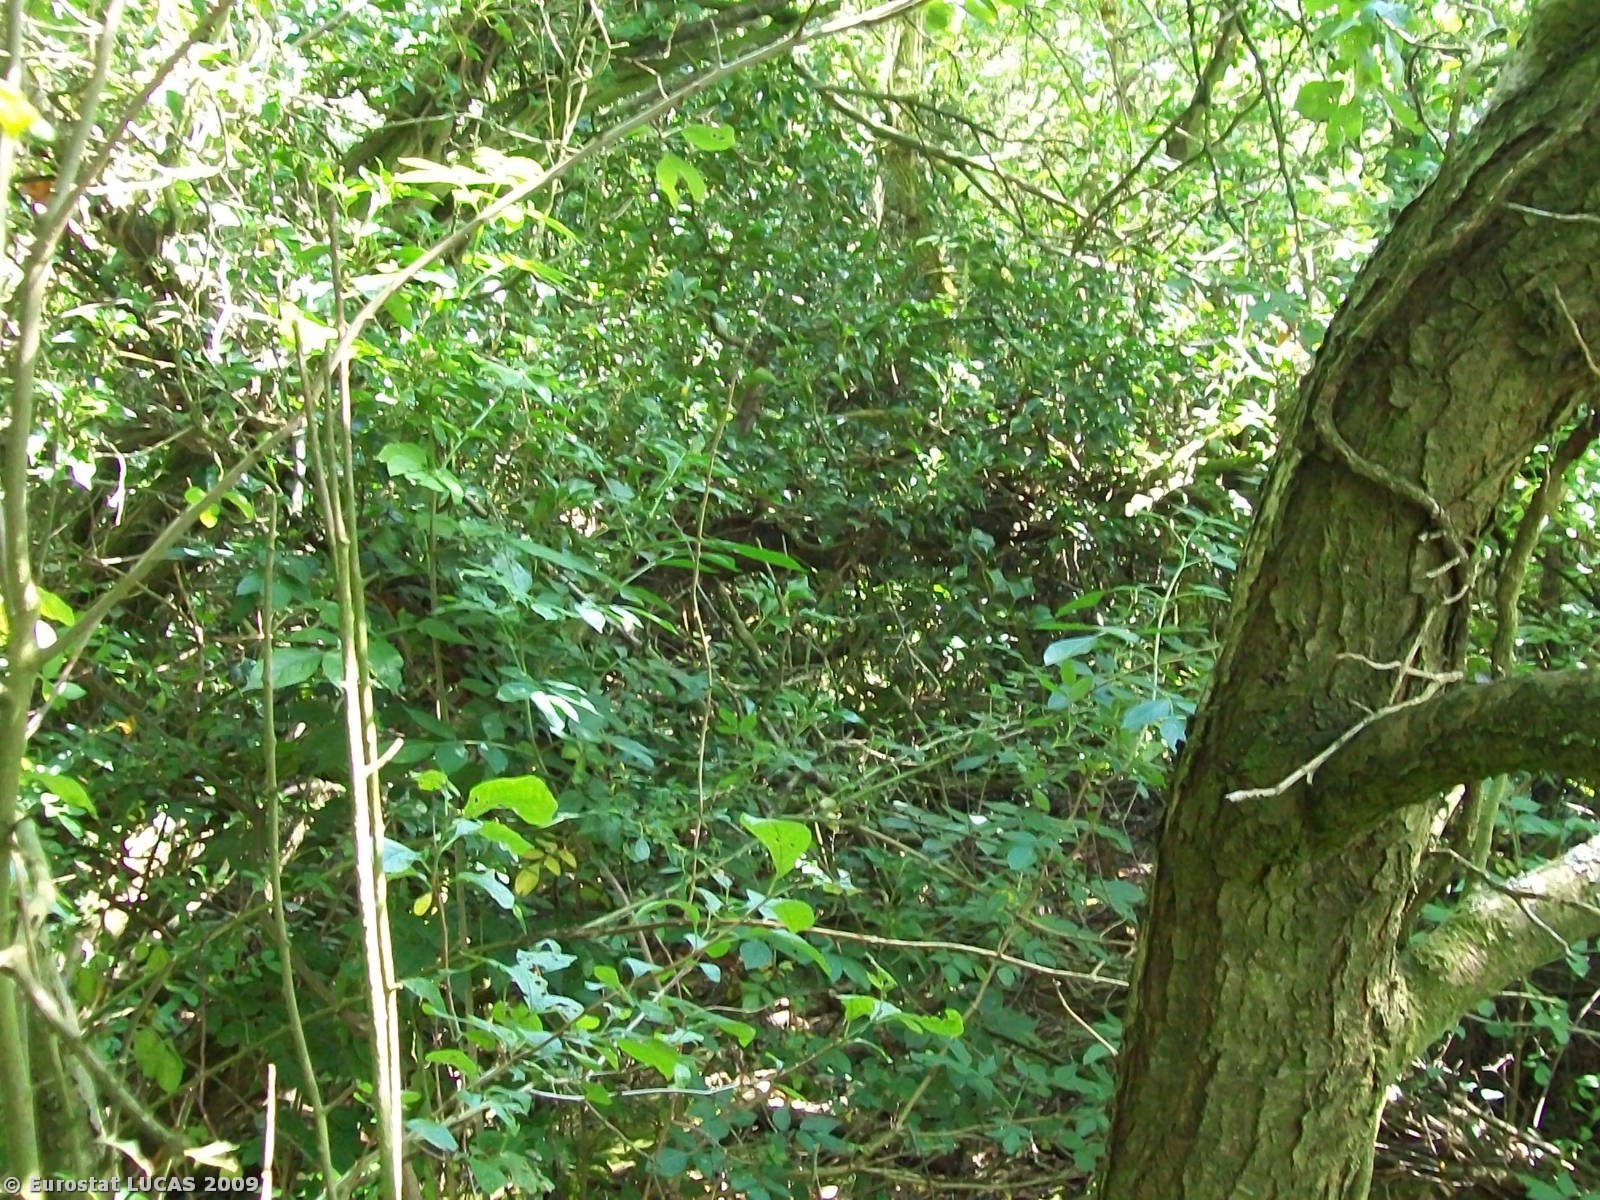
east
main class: Woodland
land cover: Broadleaved woodland
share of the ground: > 75 %
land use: Unused
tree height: > 5 m
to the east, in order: Broadleaved woodland; Grassland without tree/shrub cover
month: August
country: GB
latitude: 51.6021
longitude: -2.3506
